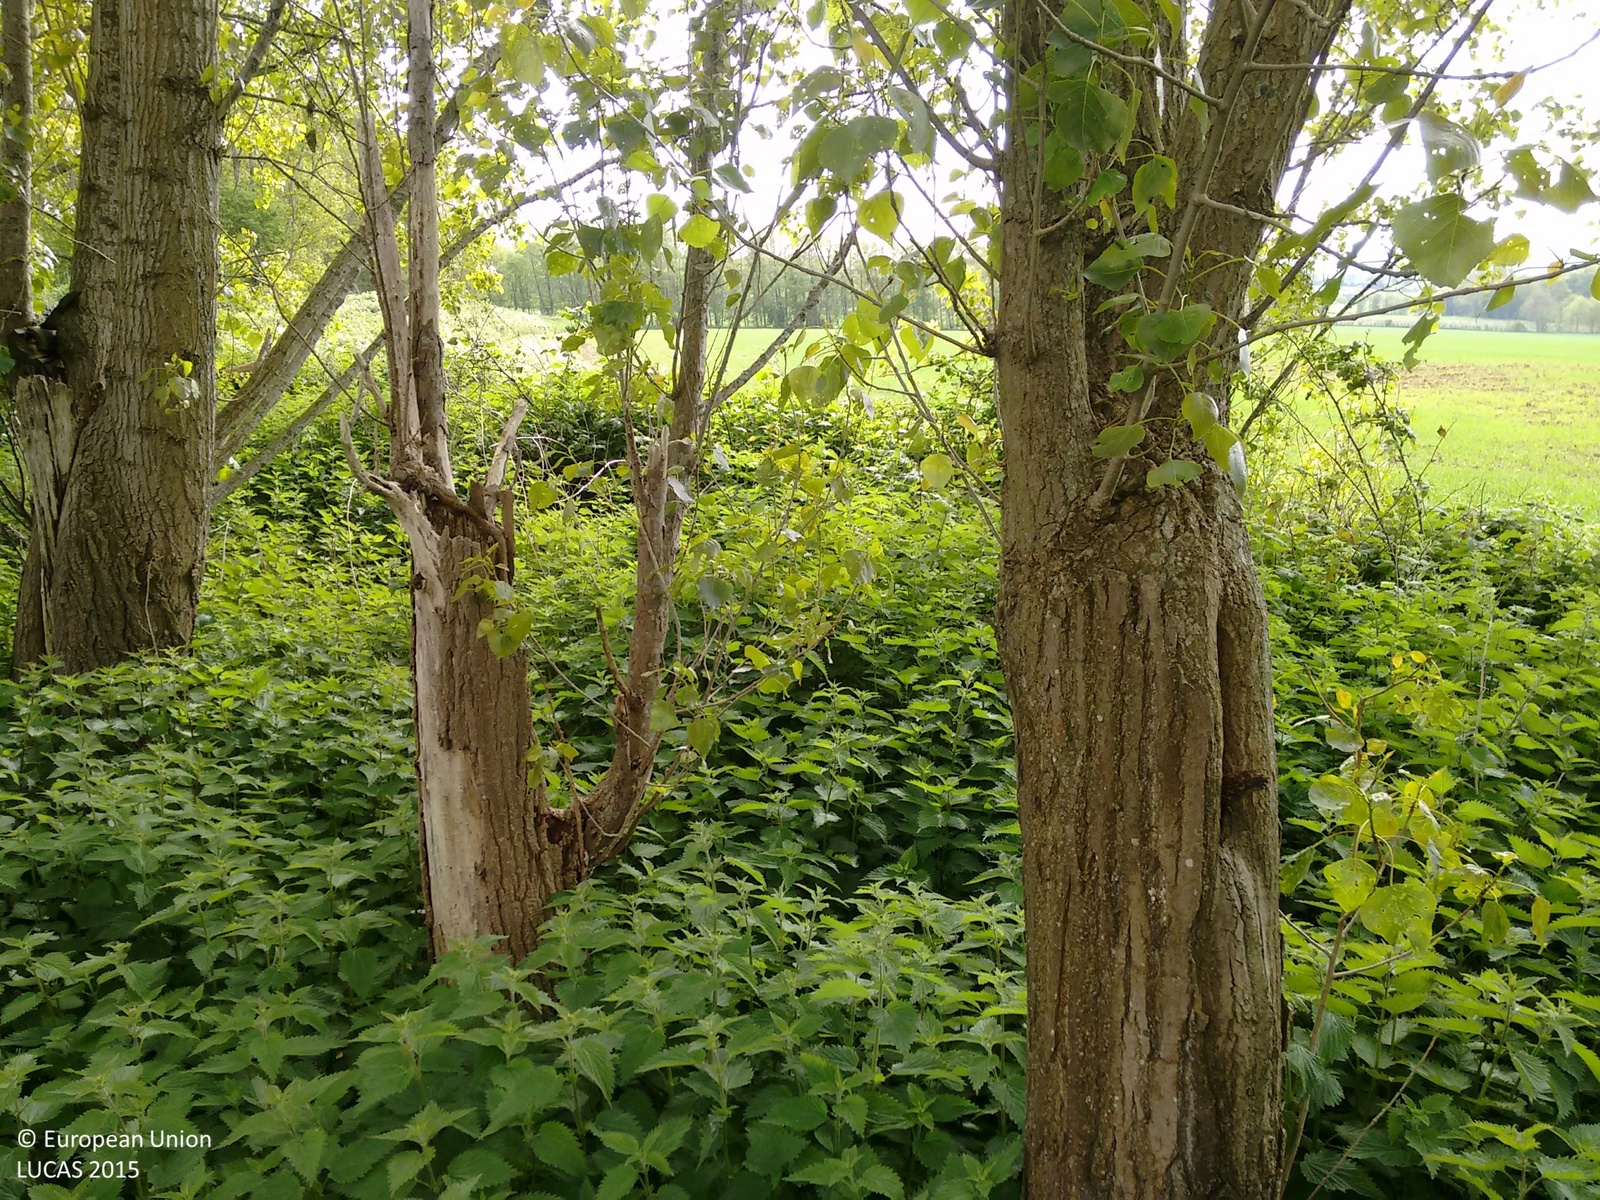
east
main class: Woodland
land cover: Broadleaved woodland
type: mesophytic deciduous forest
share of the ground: > 75 %
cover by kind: broadleaved forest trees 85 %, herbaceous plants 10 %, shrubs 5 %
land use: Forestry
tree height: > 5 m
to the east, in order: Broadleaved woodland; Tracks; Common wheat; Tracks; Shruby margins; Managed hedges; Shruby margins; Common wheat
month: May
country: GB
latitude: 51.2643
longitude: 0.4122
